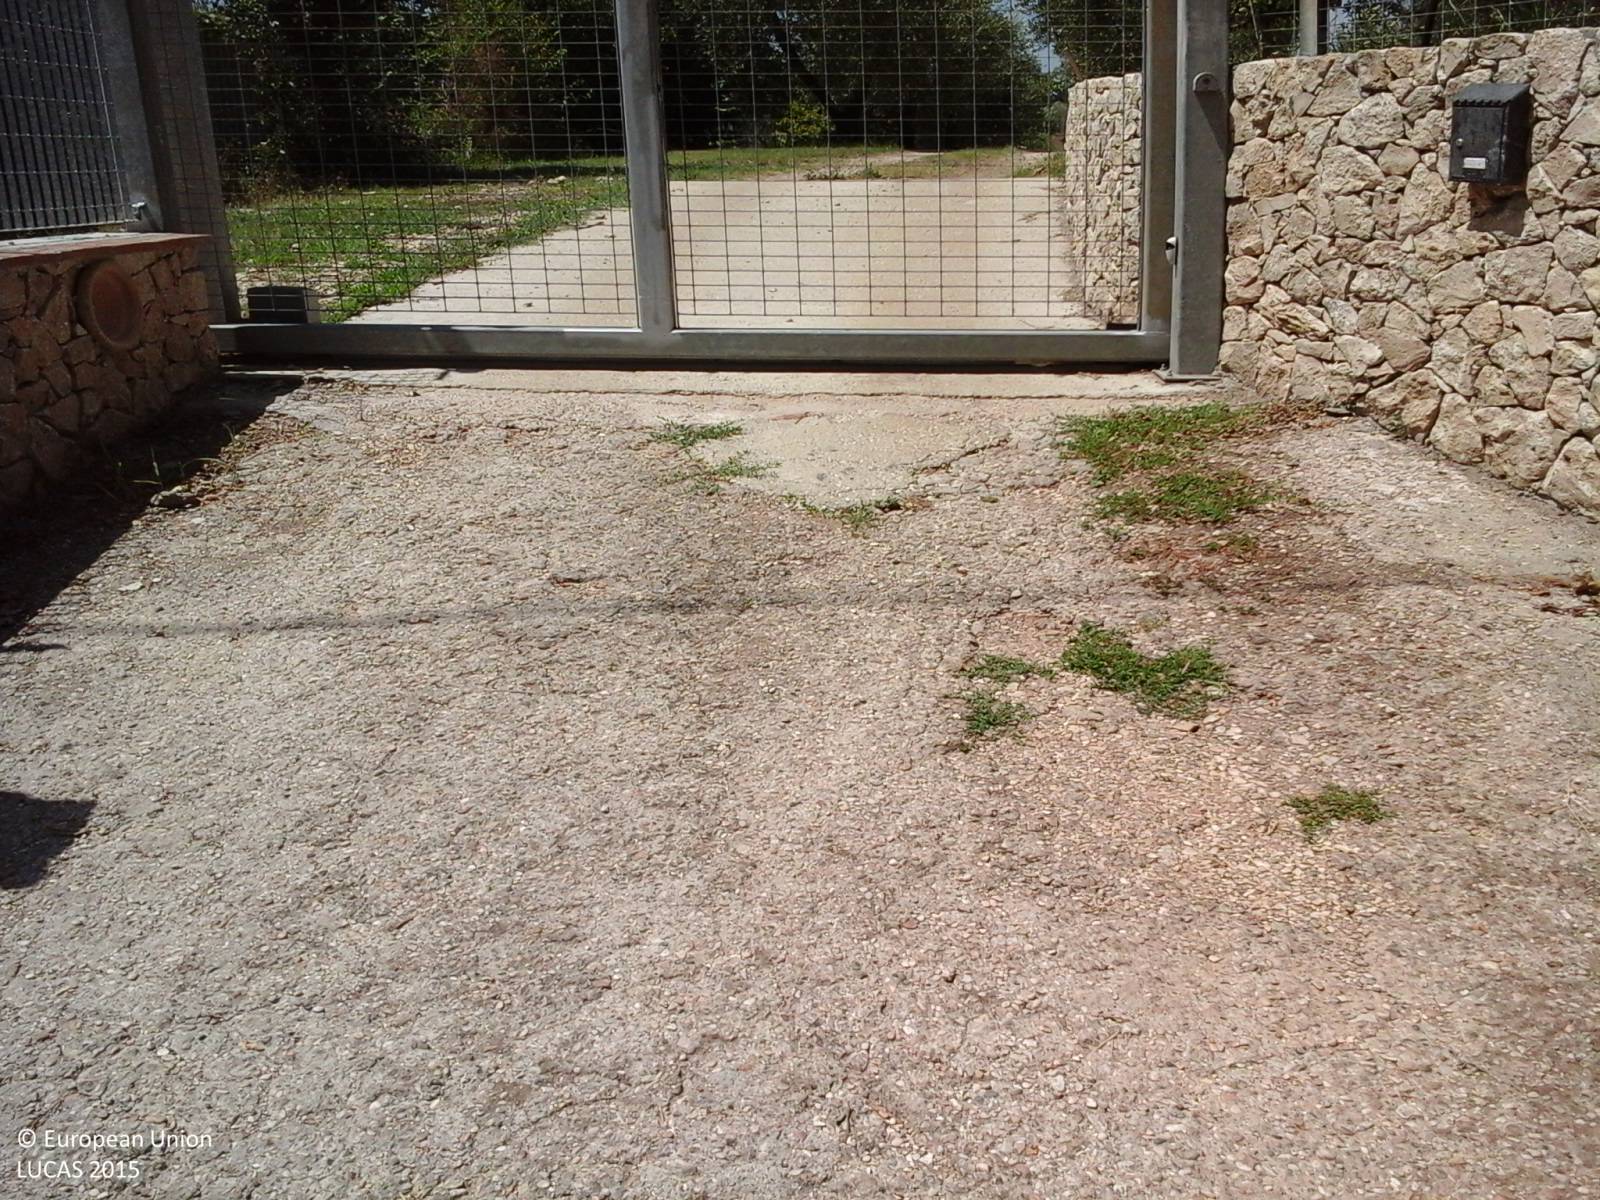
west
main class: Cropland
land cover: Olive groves
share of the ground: > 75 %
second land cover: Spontaneously vegetated surfaces
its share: > 75 %
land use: Kitchen garden
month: July
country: IT
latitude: 42.2250
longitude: 12.5234
